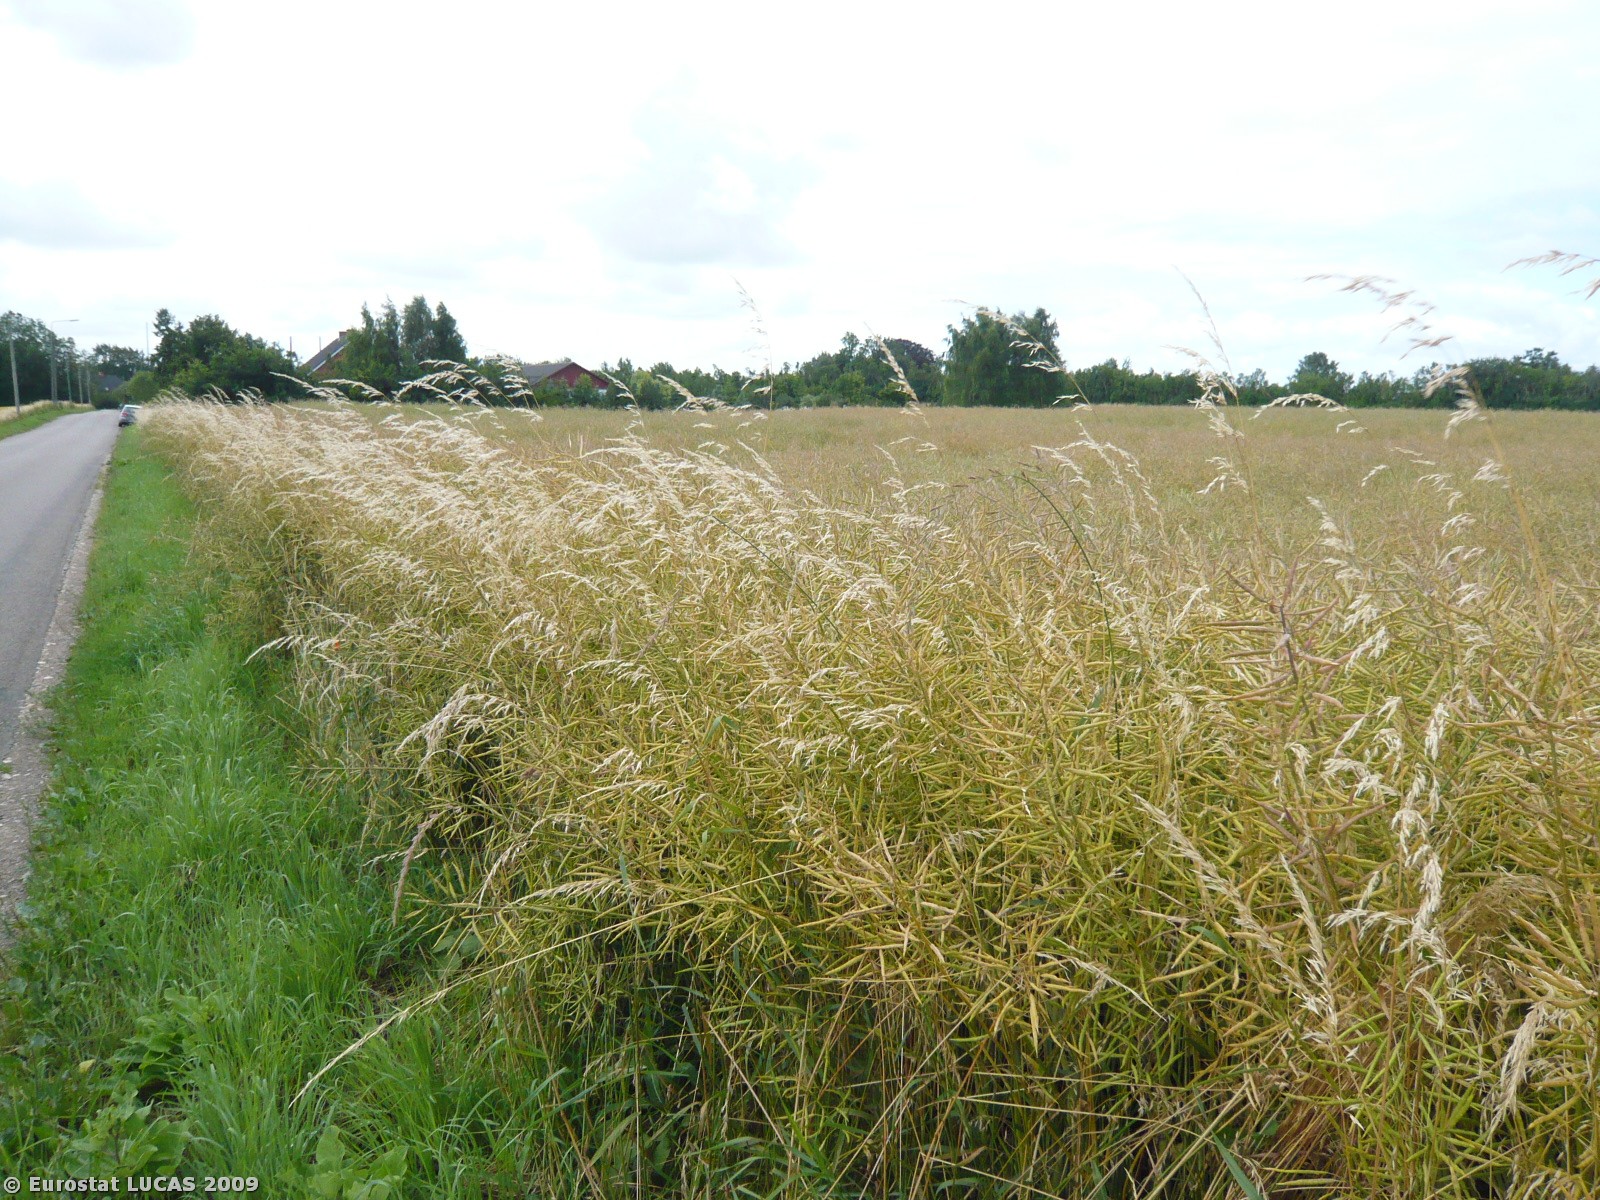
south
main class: Cropland
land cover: Rape and turnip rape
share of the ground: > 75 %
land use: Agriculture (excluding fallow land and kitchen gardens)
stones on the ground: < 10 %
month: July
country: DK
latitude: 55.5162
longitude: 11.2816
